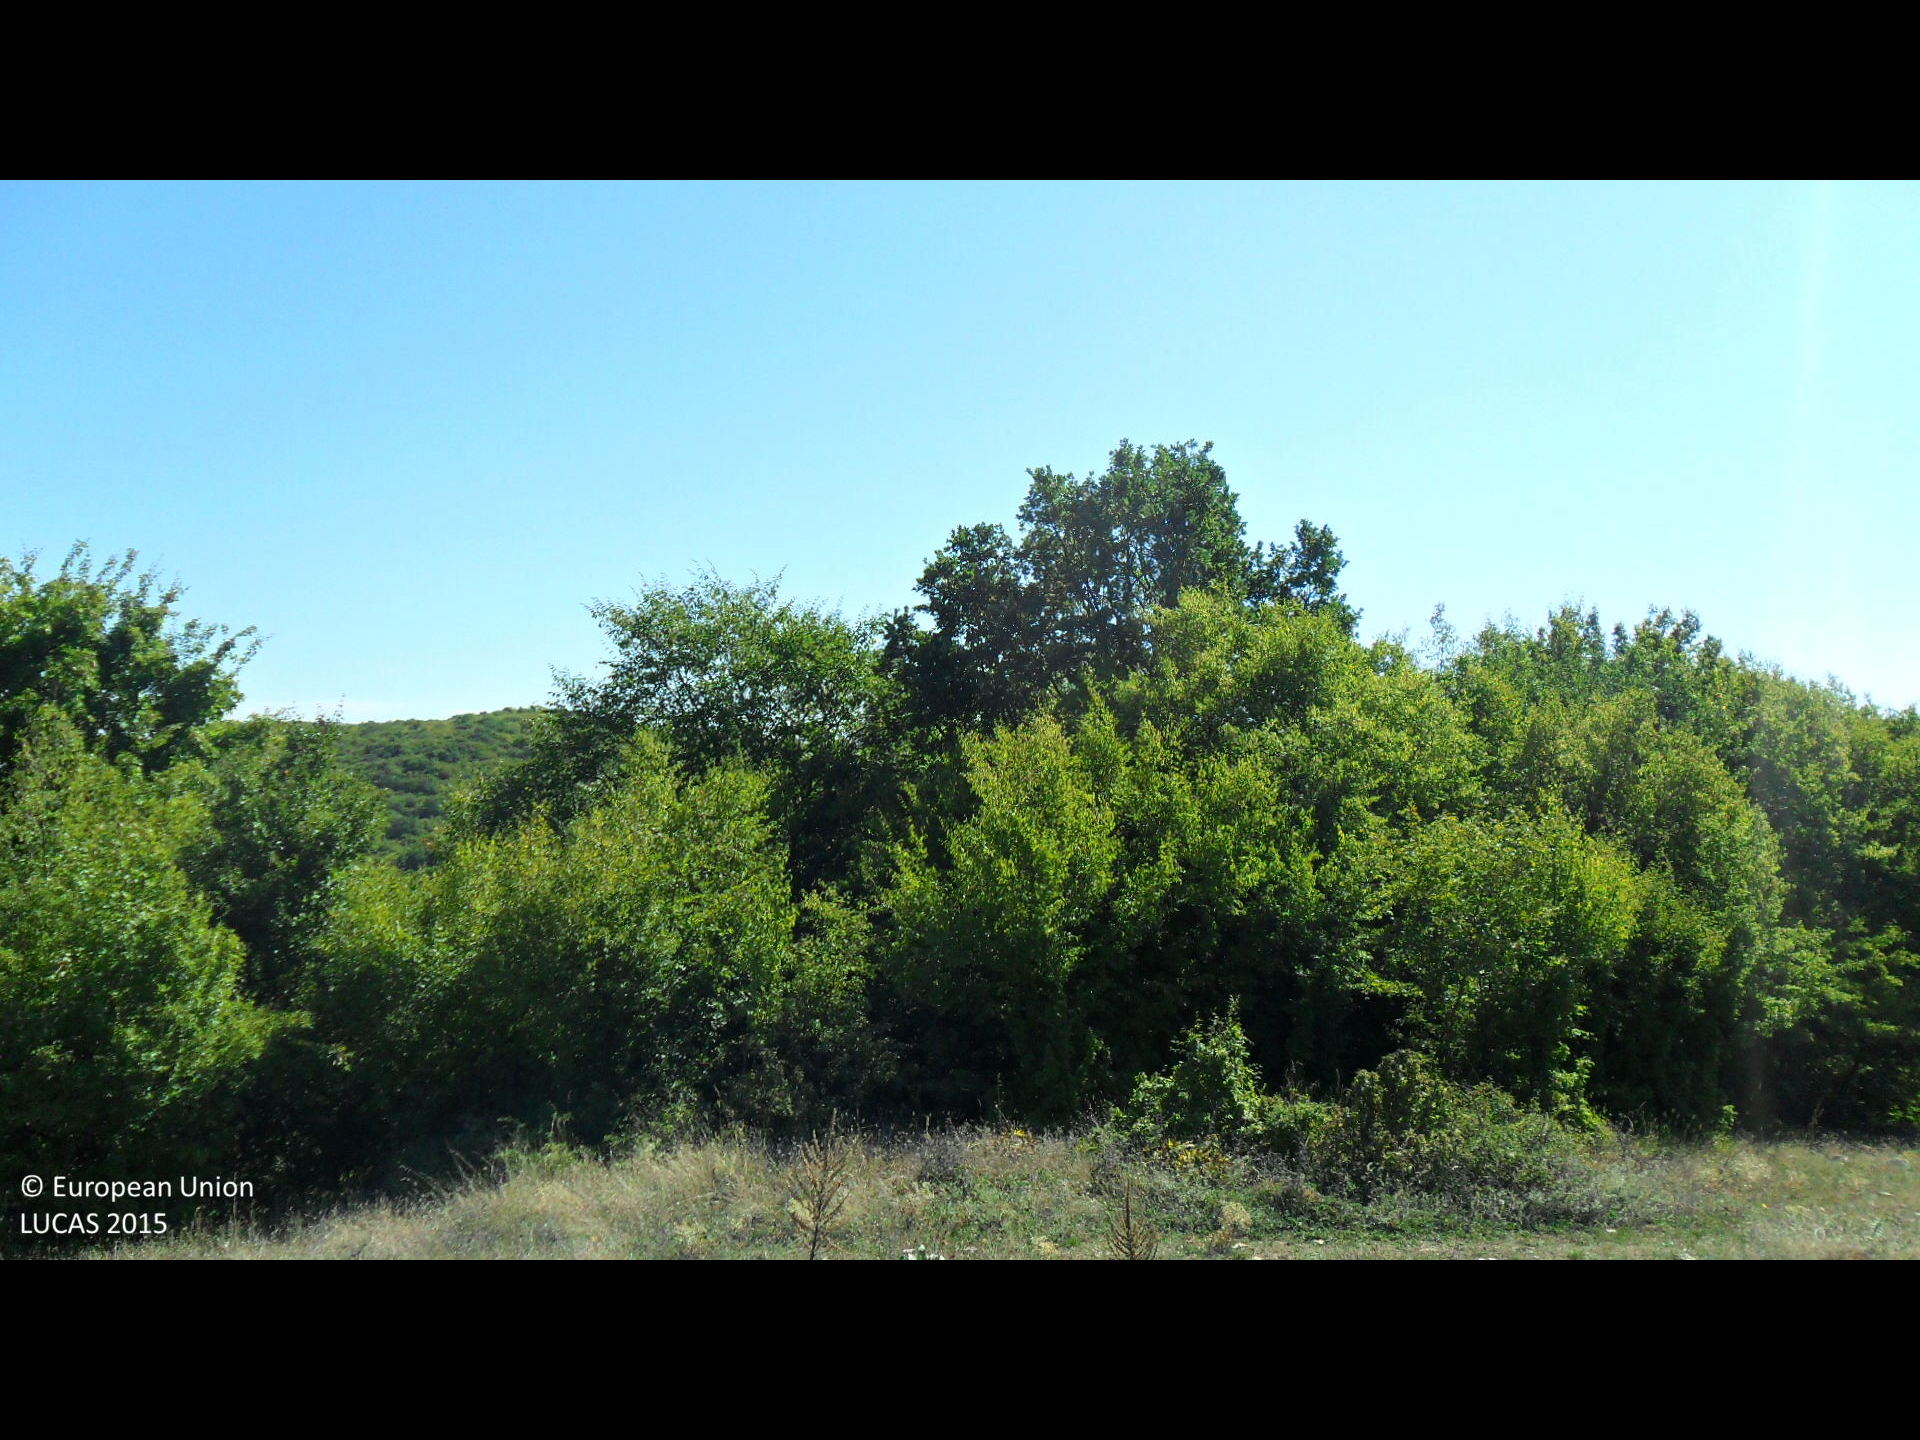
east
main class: Grassland
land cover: Grassland with sparse tree/shrub cover
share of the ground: > 75 %
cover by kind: herbaceous plants 90 %, broadleaved forest trees 5 %, shrubs 5 %
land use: Agriculture (excluding fallow land and kitchen gardens)
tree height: > 5 m
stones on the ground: 25 - 50 %
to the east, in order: Grassland with sparse tree/shrub cover; Broadleaved woodland; Tracks; Broadleaved woodland
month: September
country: BG
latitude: 43.2053
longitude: 26.4824
